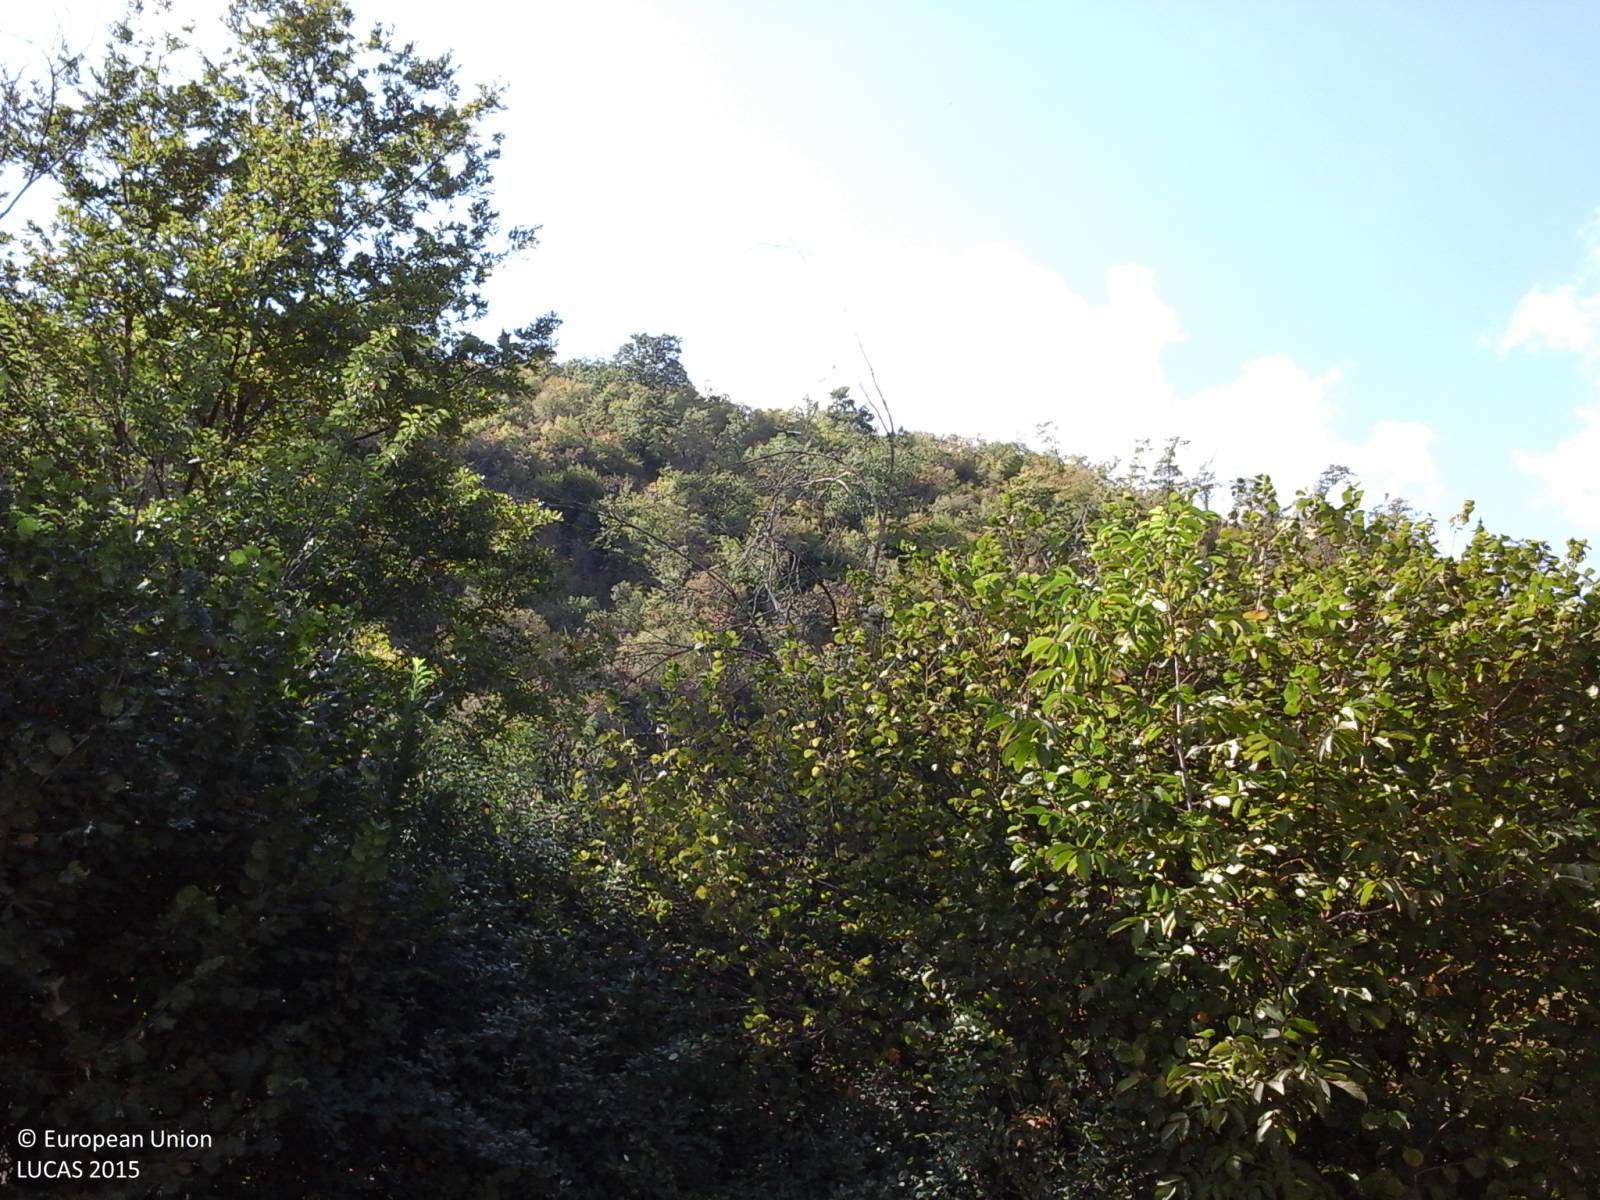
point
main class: Woodland
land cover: Broadleaved woodland
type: thermophilous deciduous forest
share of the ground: > 75 %
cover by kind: broadleaved forest trees 85 %, shrubs 15 %
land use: Forestry
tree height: > 5 m
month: October
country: IT
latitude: 42.3062
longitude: 12.8654
